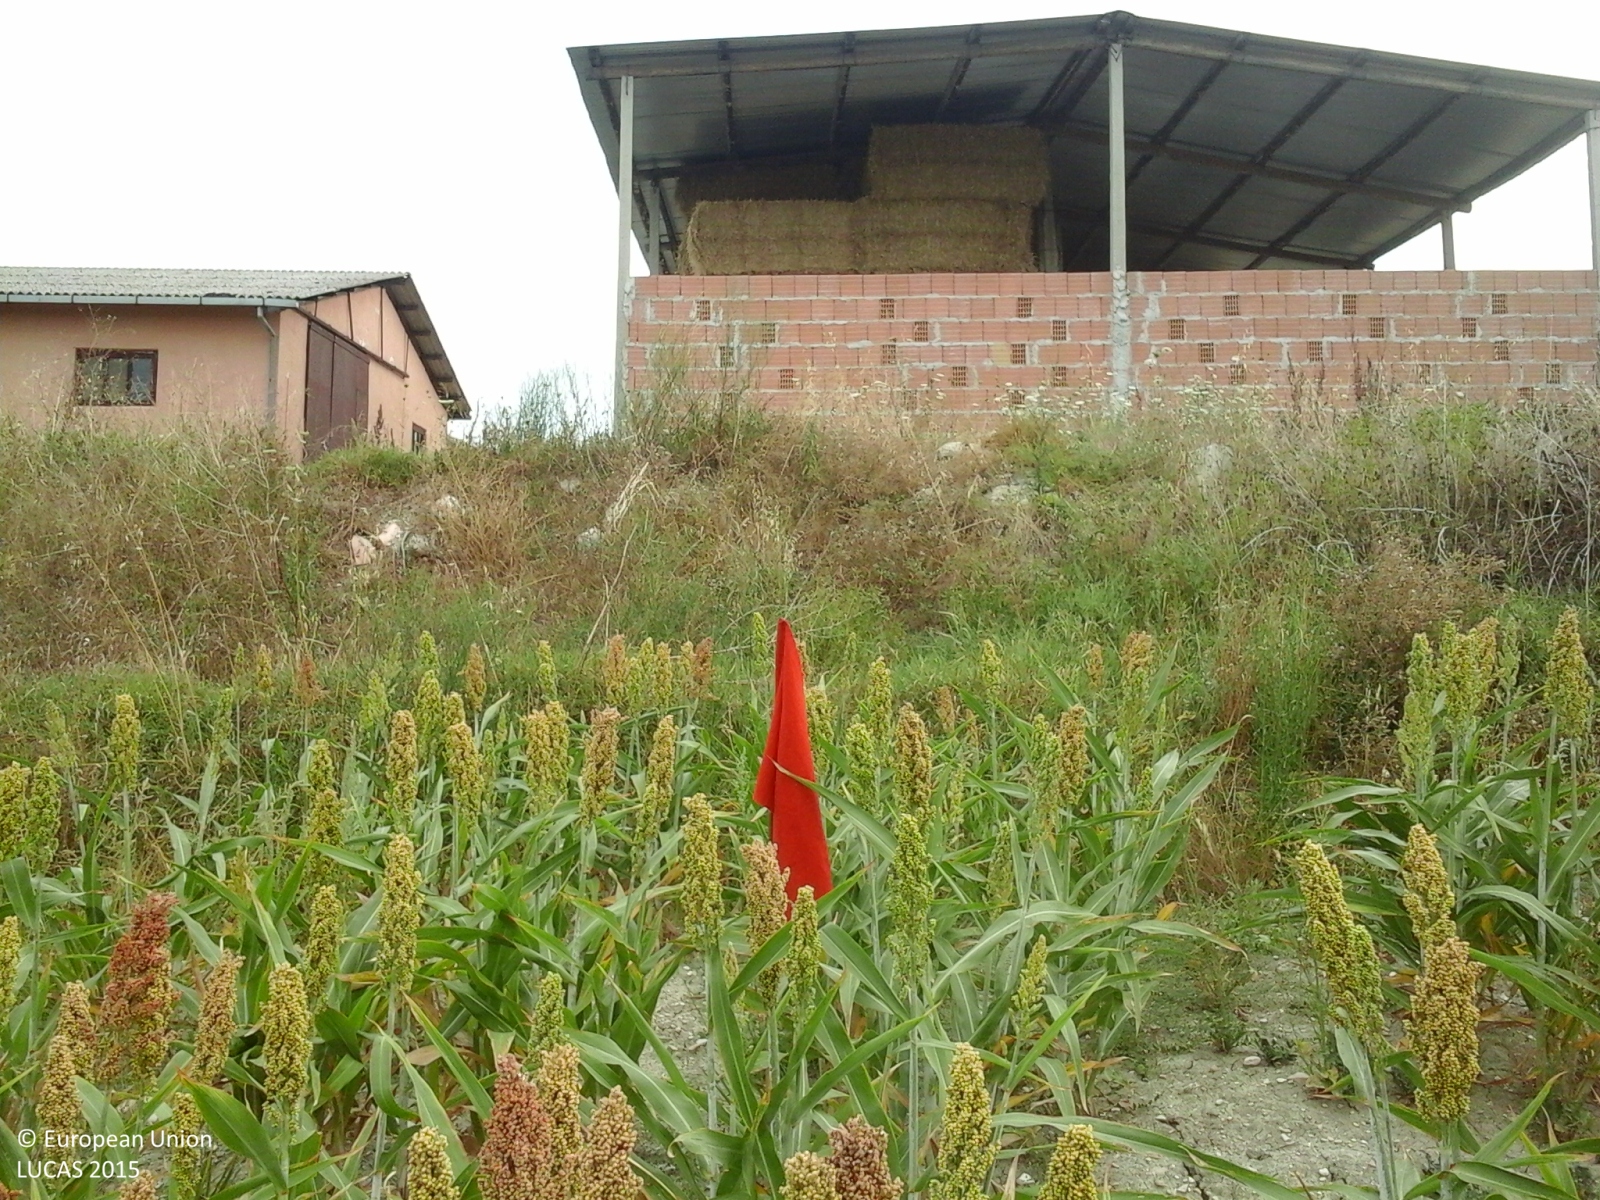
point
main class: Cropland
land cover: Other cereals
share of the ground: > 75 %
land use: Agriculture (excluding fallow land and kitchen gardens)
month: August
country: IT
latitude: 43.3015
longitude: 13.4059
